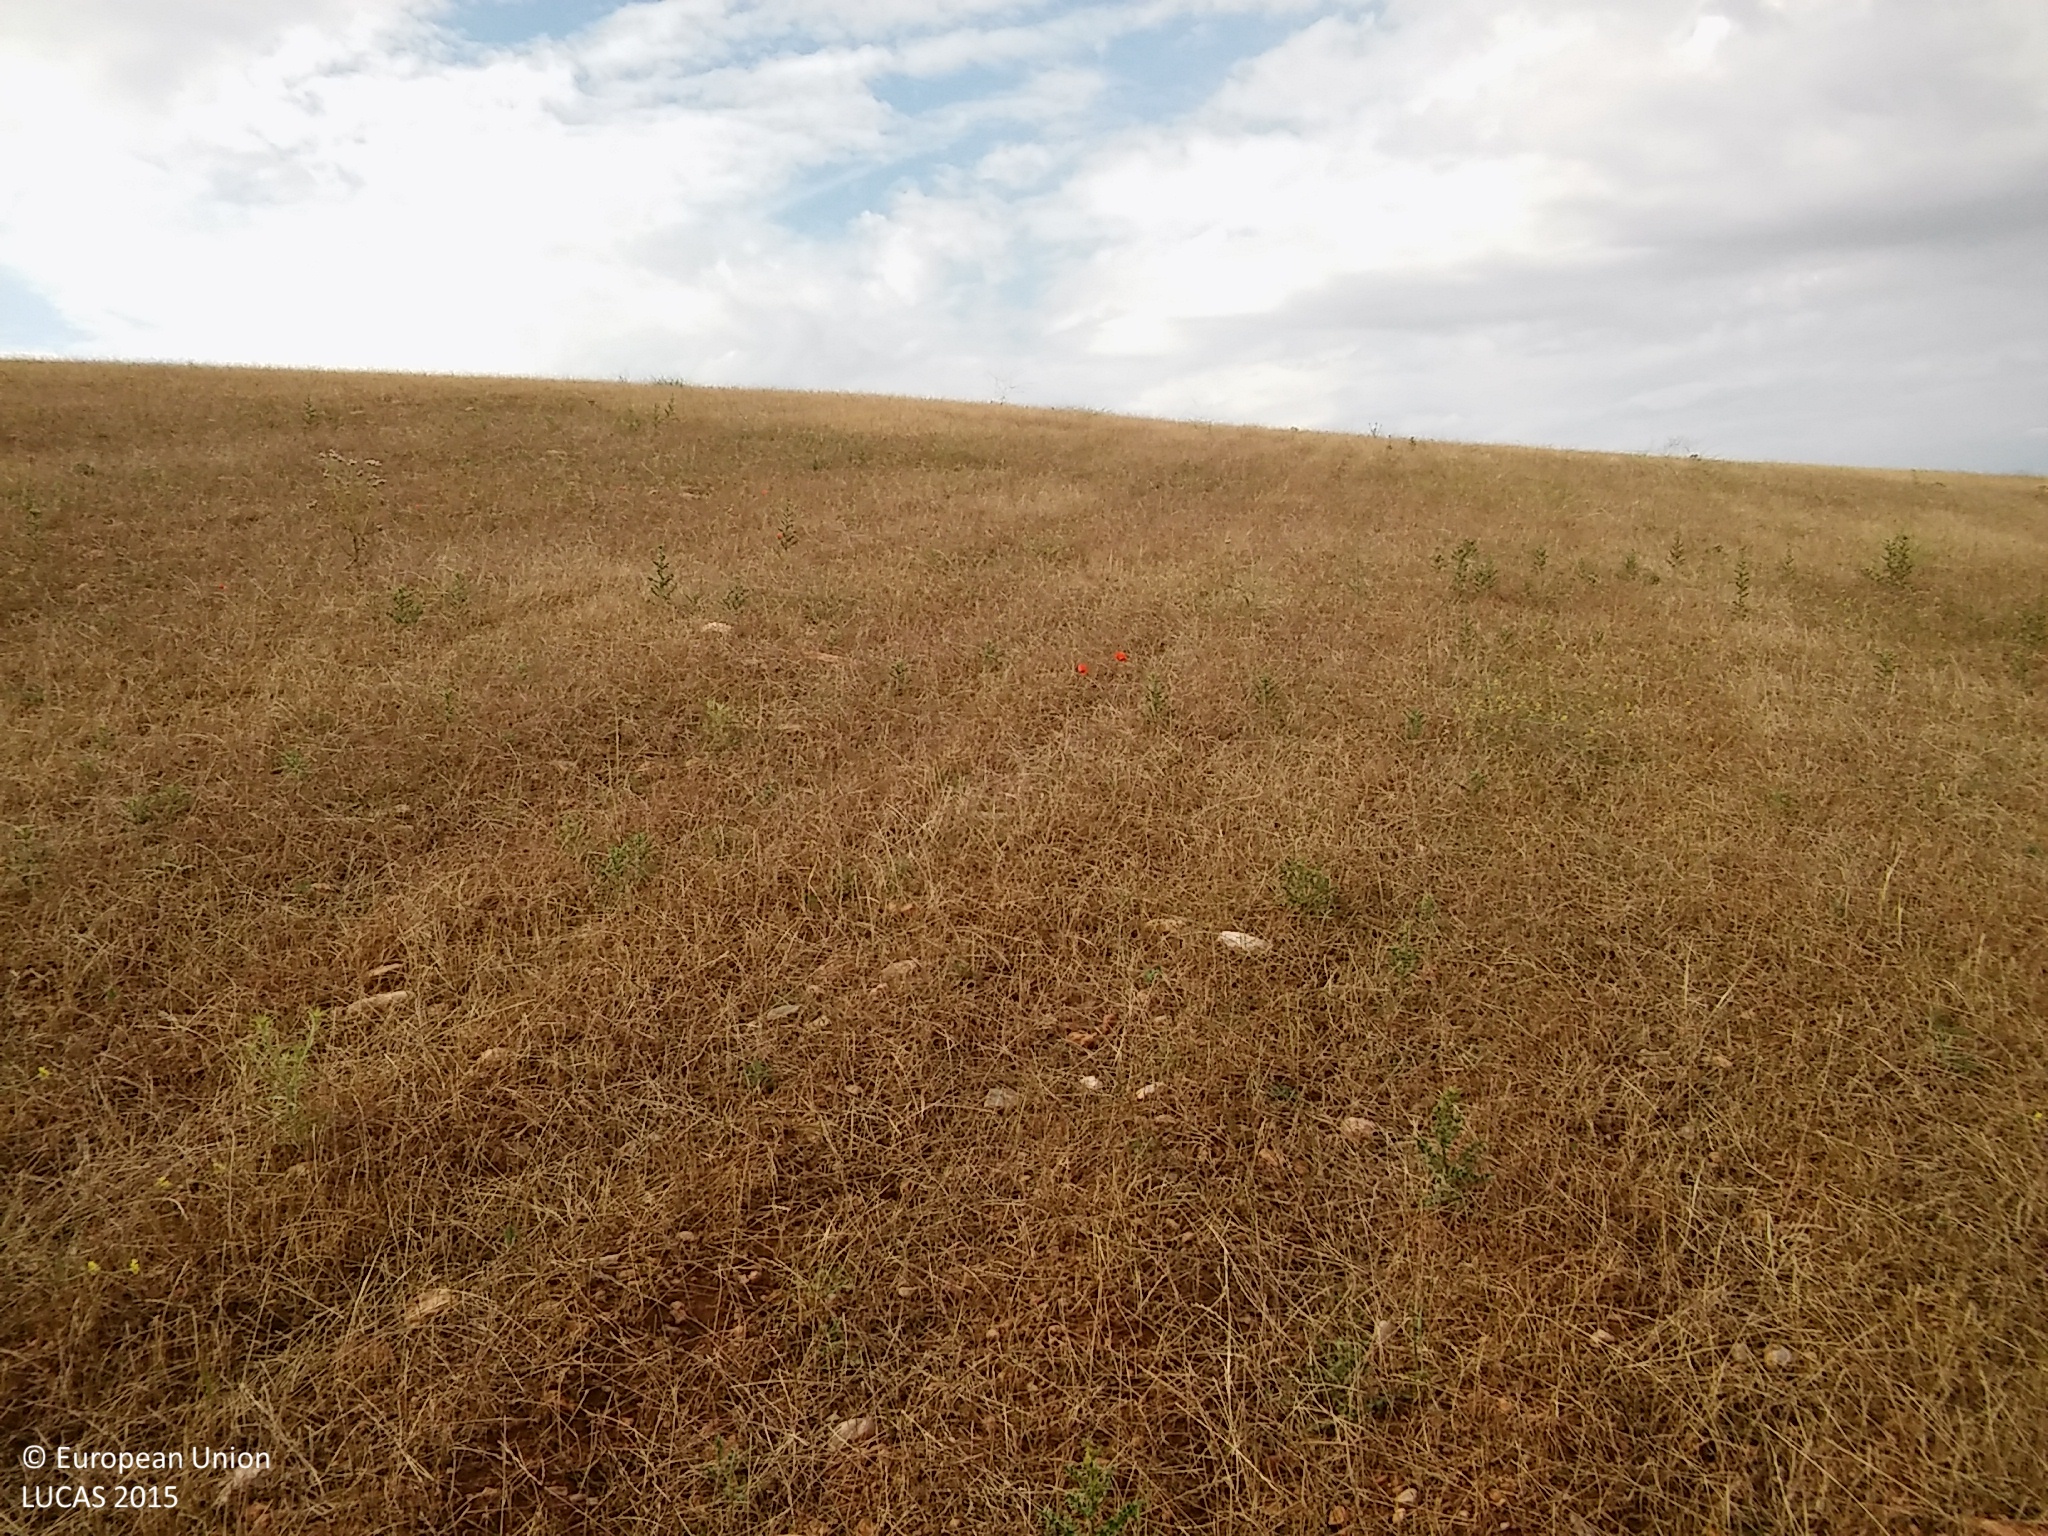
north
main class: Grassland
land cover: Spontaneously vegetated surfaces
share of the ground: > 75 %
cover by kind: herbaceous plants 60 %, unconsolidated bare surface 40 %
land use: Fallow land
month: June
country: ES
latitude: 41.5348
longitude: -3.7033
